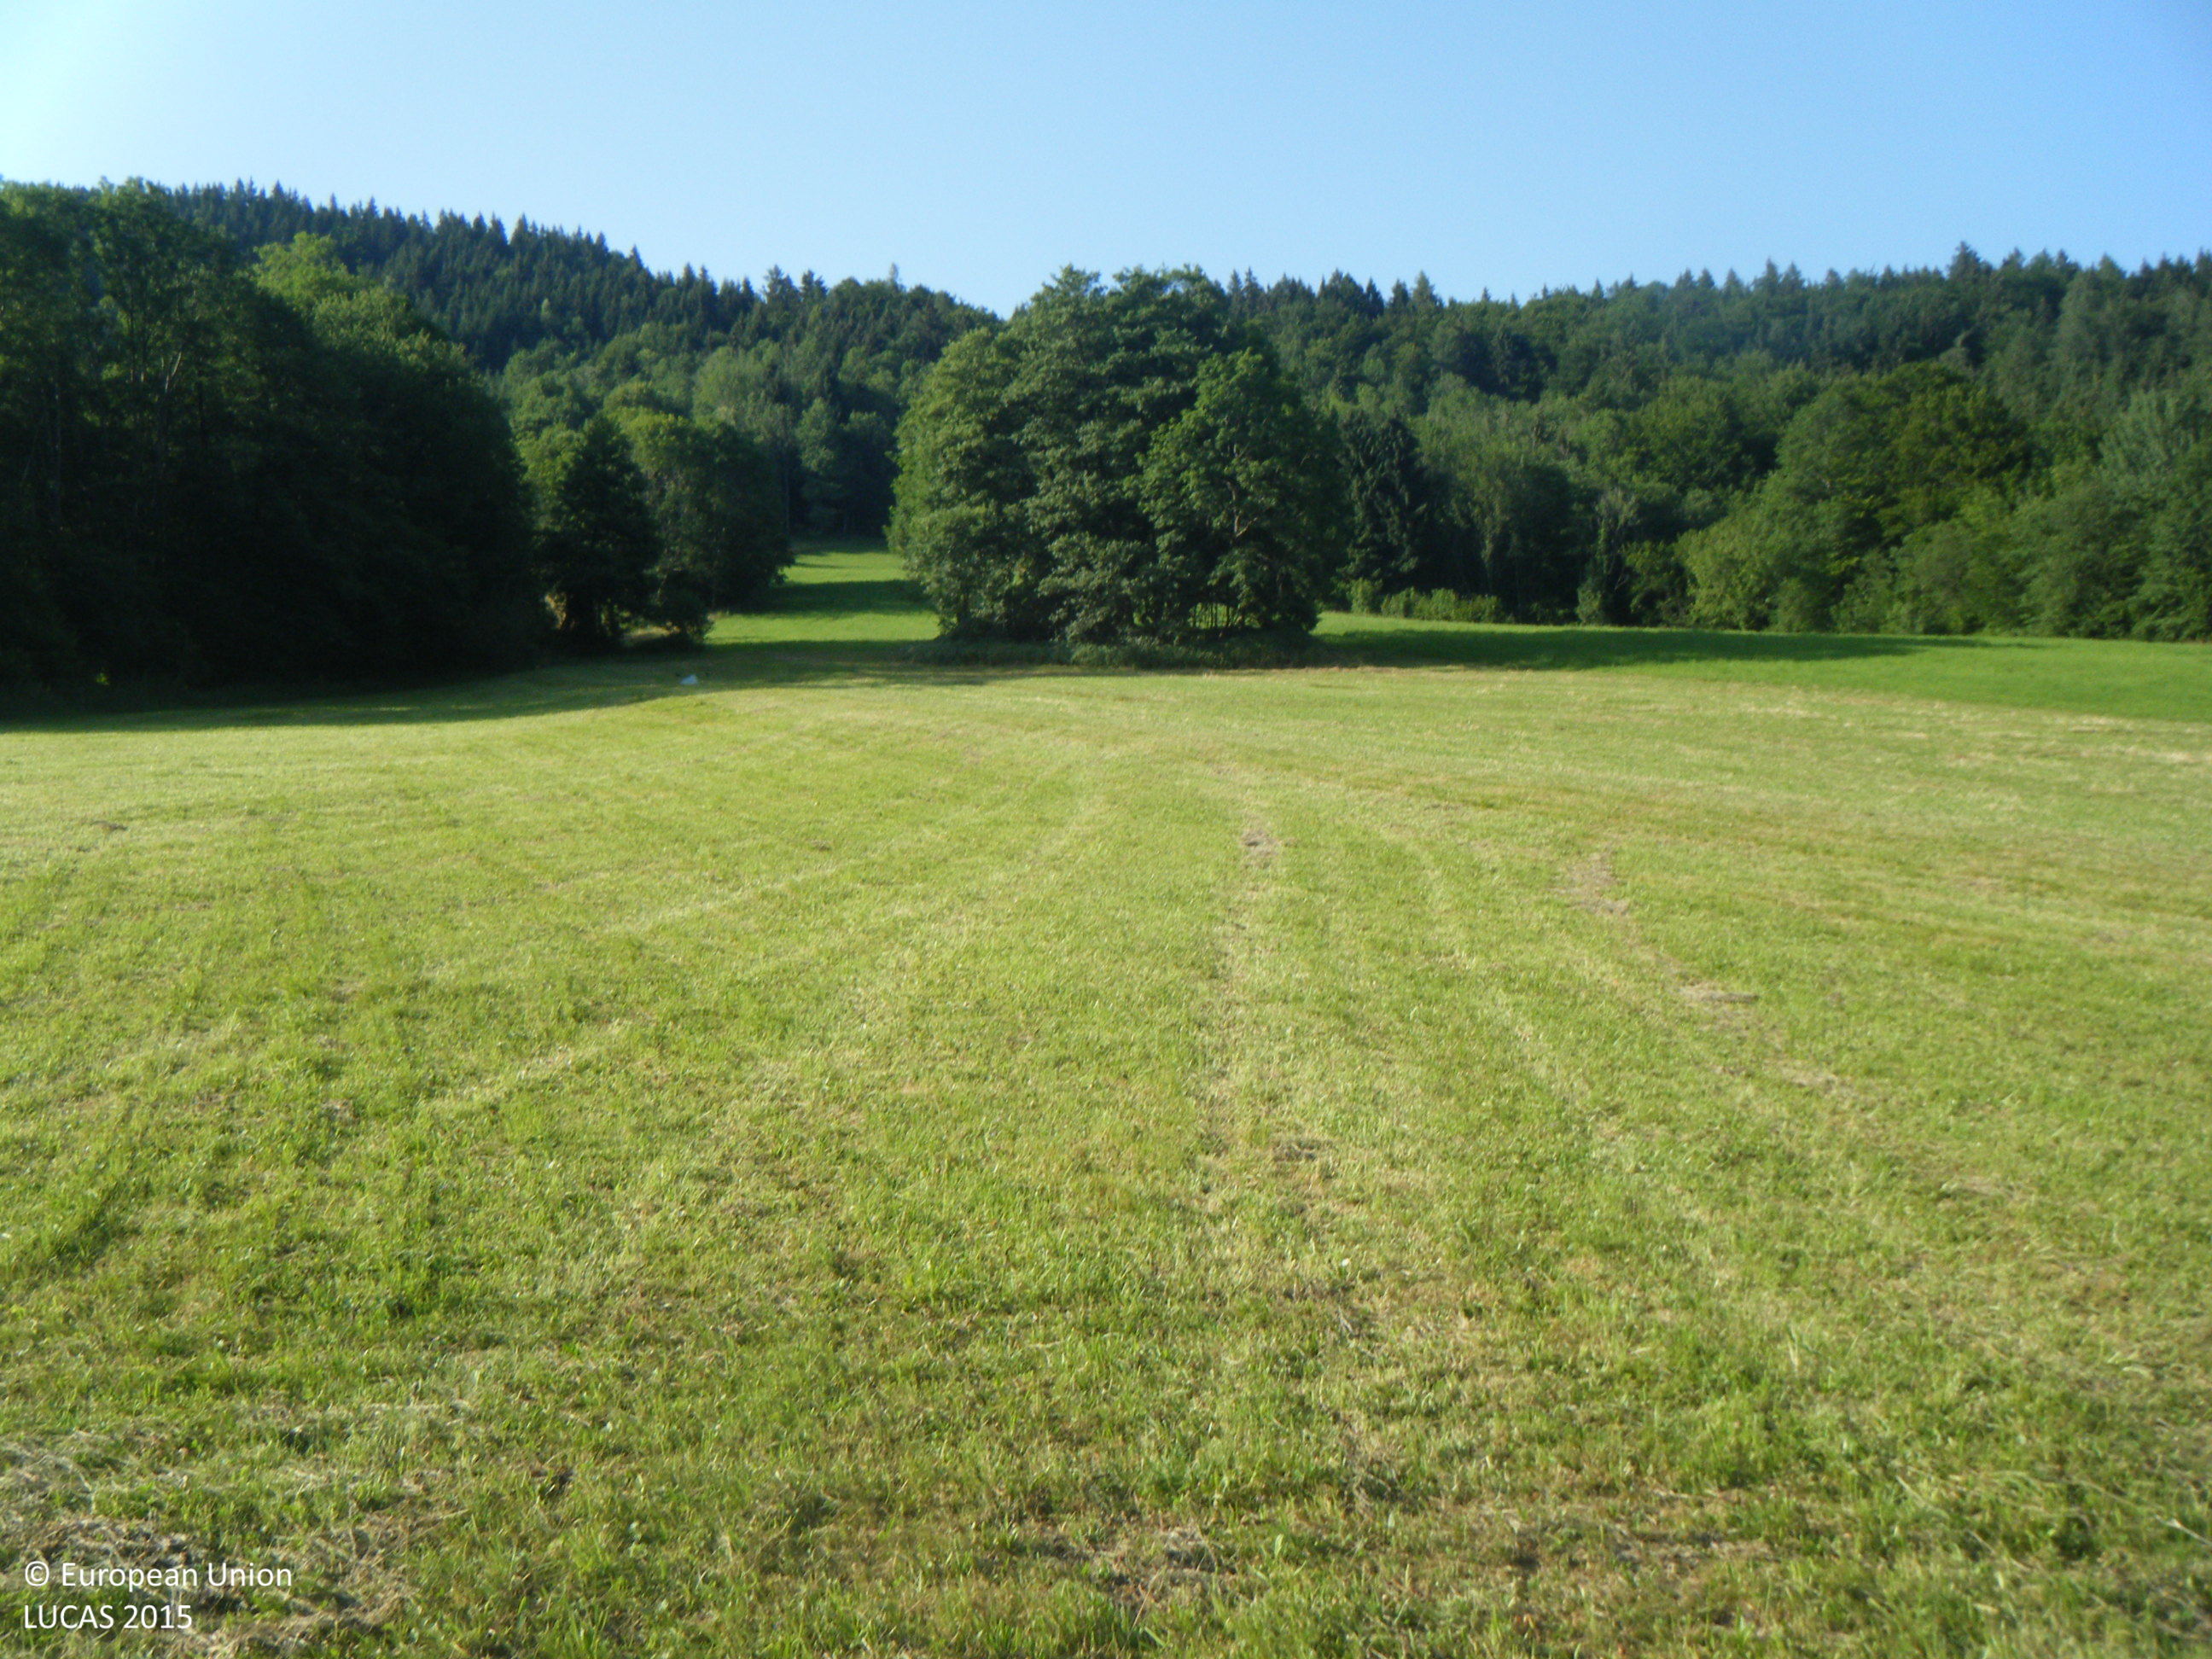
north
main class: Grassland
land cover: Grassland without tree/shrub cover
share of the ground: > 75 %
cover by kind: herbaceous plants 100 %
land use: Agriculture (excluding fallow land and kitchen gardens)
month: July
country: AT
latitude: 47.8083
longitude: 13.4840
